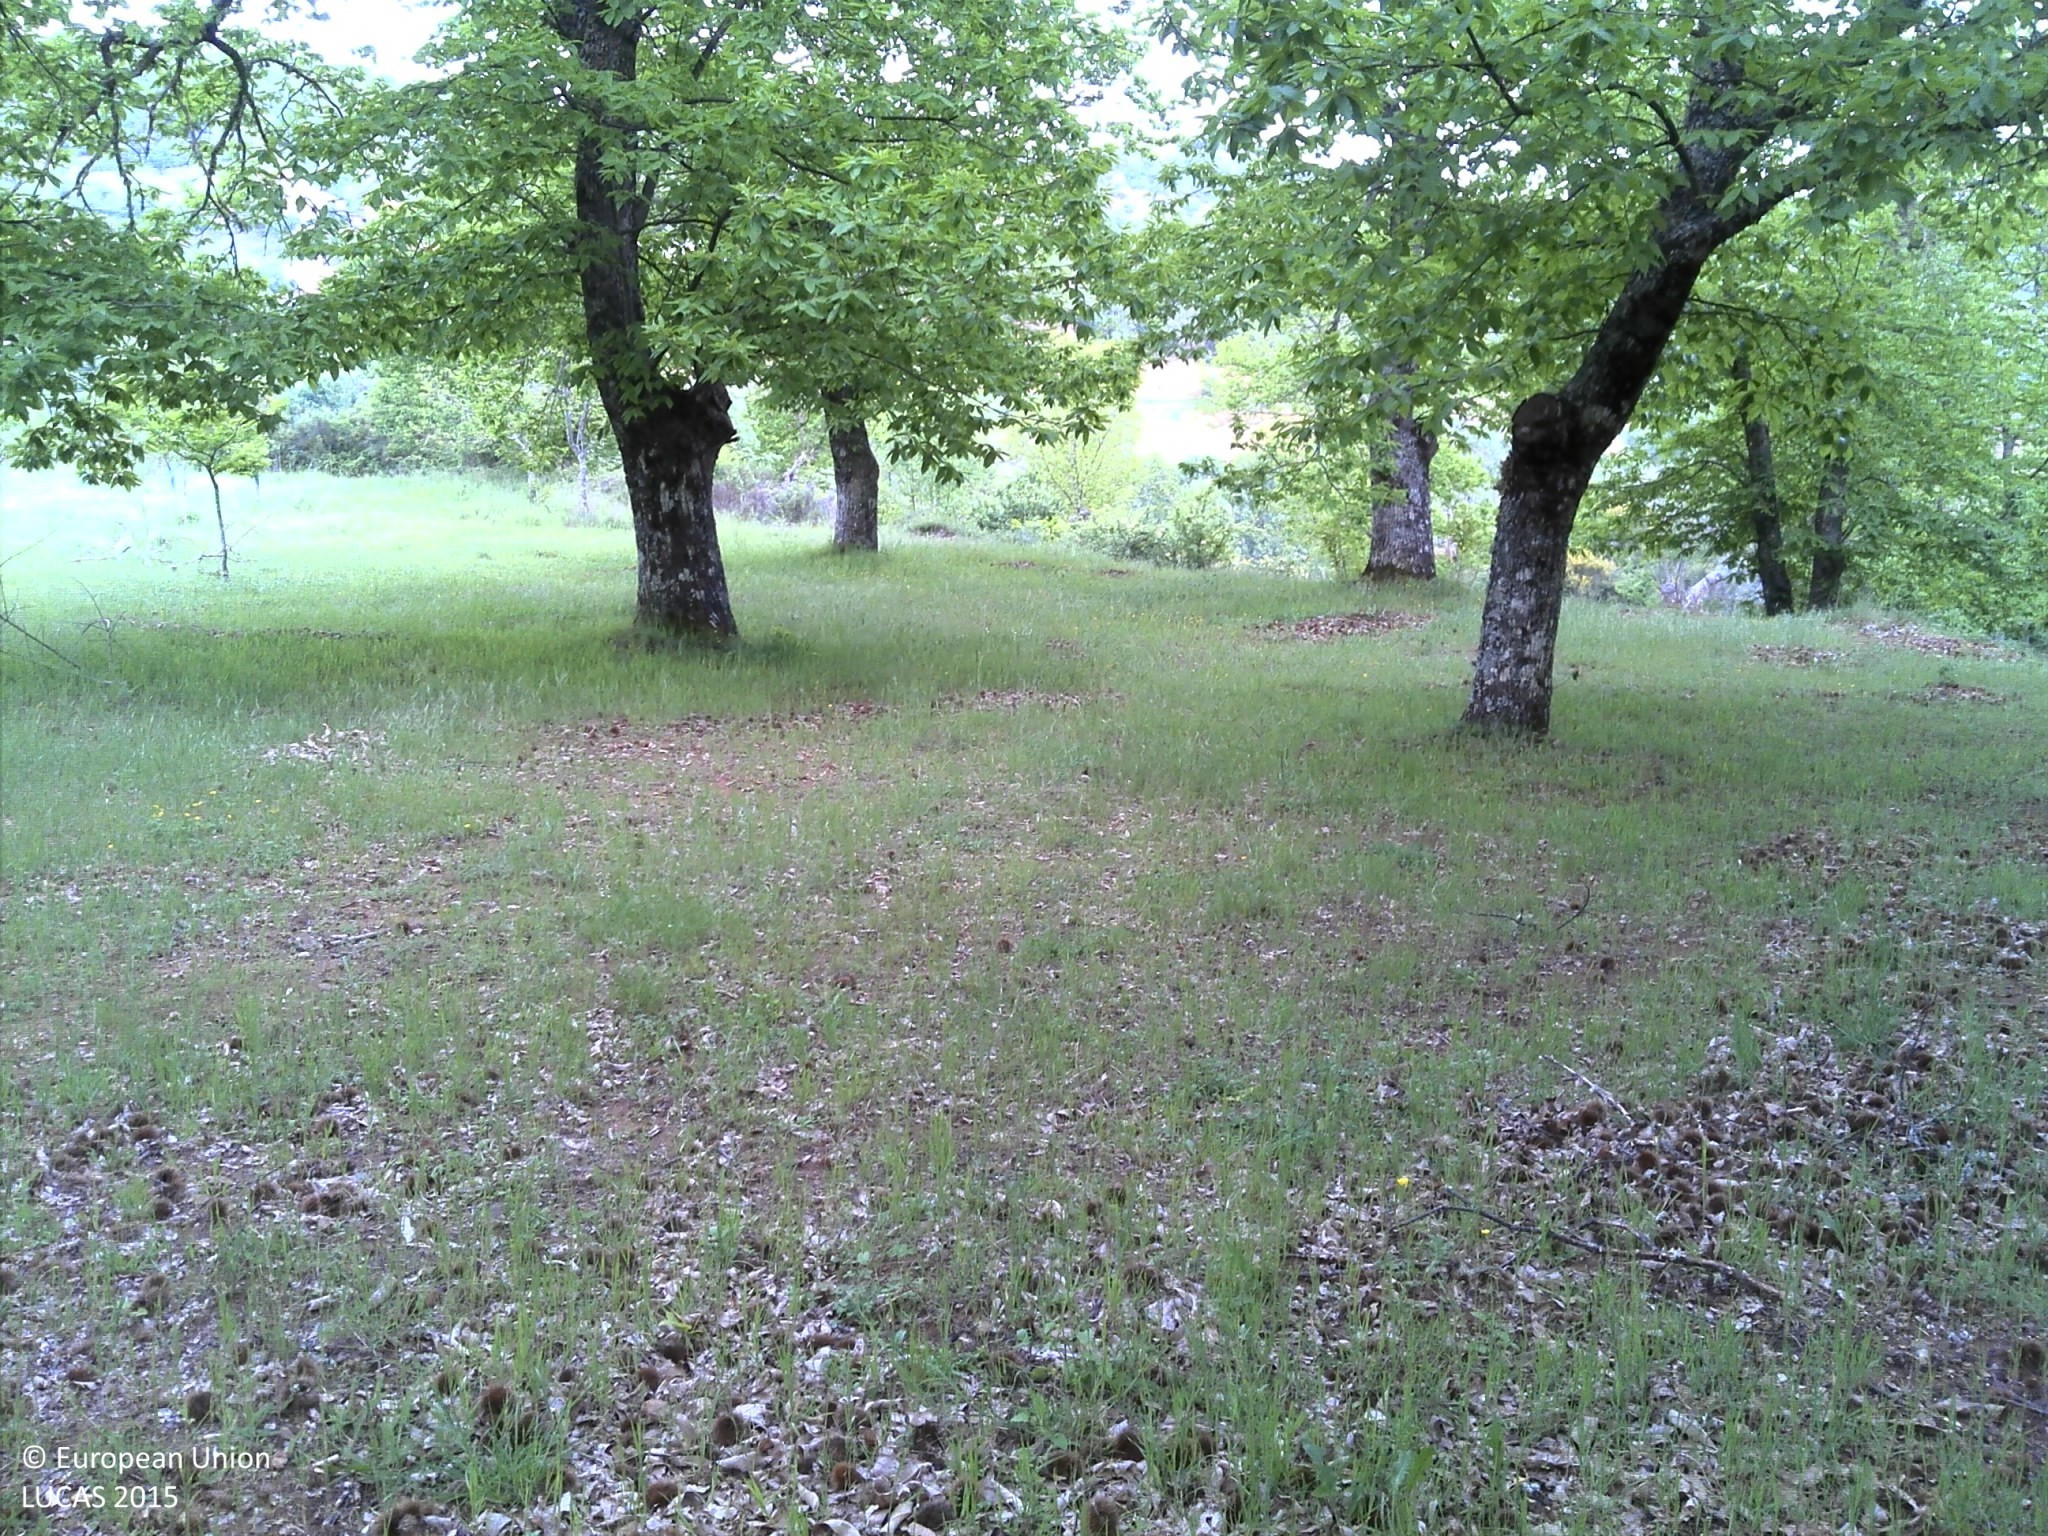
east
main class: Cropland
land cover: Nuts trees
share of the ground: 50 - 75 %
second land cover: Grassland without tree/shrub cover
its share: 25 - 50 %
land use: Agriculture (excluding fallow land and kitchen gardens)
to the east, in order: Nuts trees; Grassland without tree/shrub cover; Apple fruit; Abandoned hedges; Tracks; Single bushes/trees; Spontaneously vegetated surfaces; Apple fruit; Cherry fruit; Spontaneously vegetated surfaces; Abandoned hedges; Ditches and canals; Apple fruit; Other root crops; Spontaneously vegetated surfaces; Ponds and wetlands; Rivers and streams; Shrubland with sparse tree cover; Grassland without tree/shrub cover
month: May
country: PT
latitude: 41.8906
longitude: -7.0797
